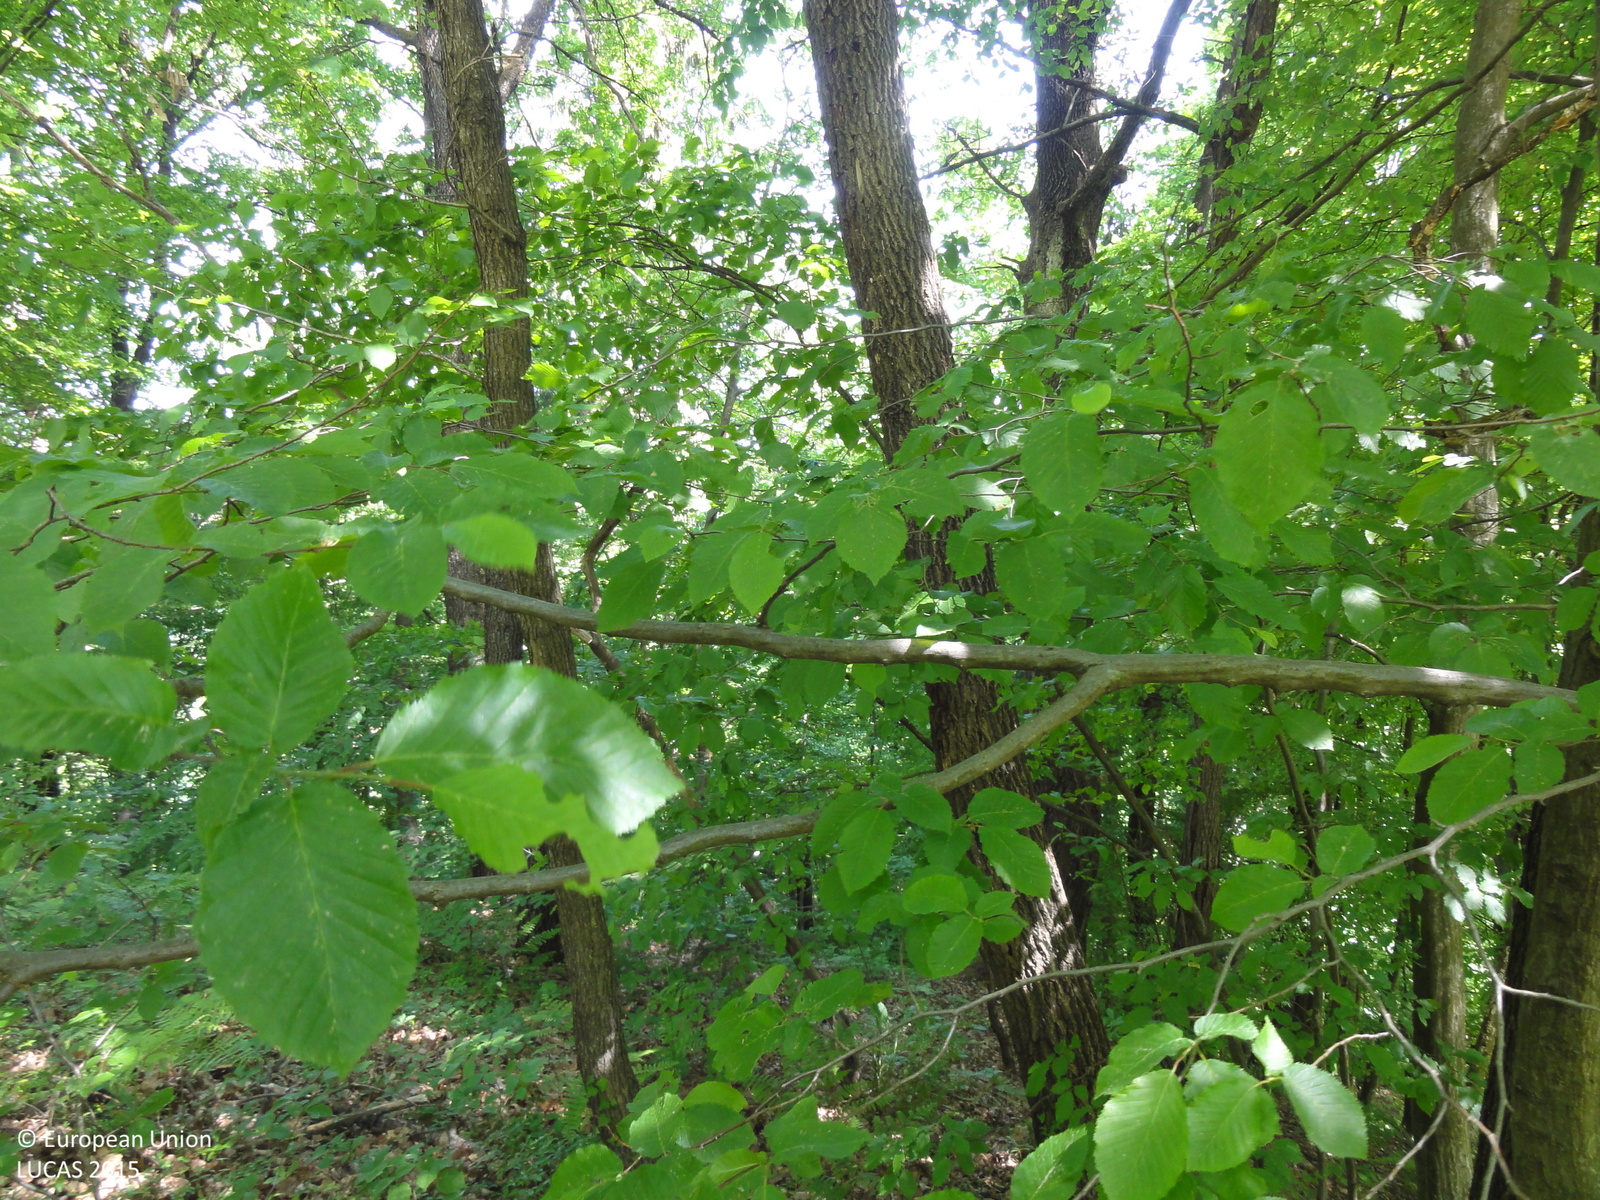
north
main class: Woodland
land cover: Broadleaved woodland
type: mesophytic deciduous forest
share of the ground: > 75 %
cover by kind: broadleaved forest trees 100 %
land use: Forestry
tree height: > 5 m
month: May
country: SI
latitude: 46.2044
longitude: 15.2465
